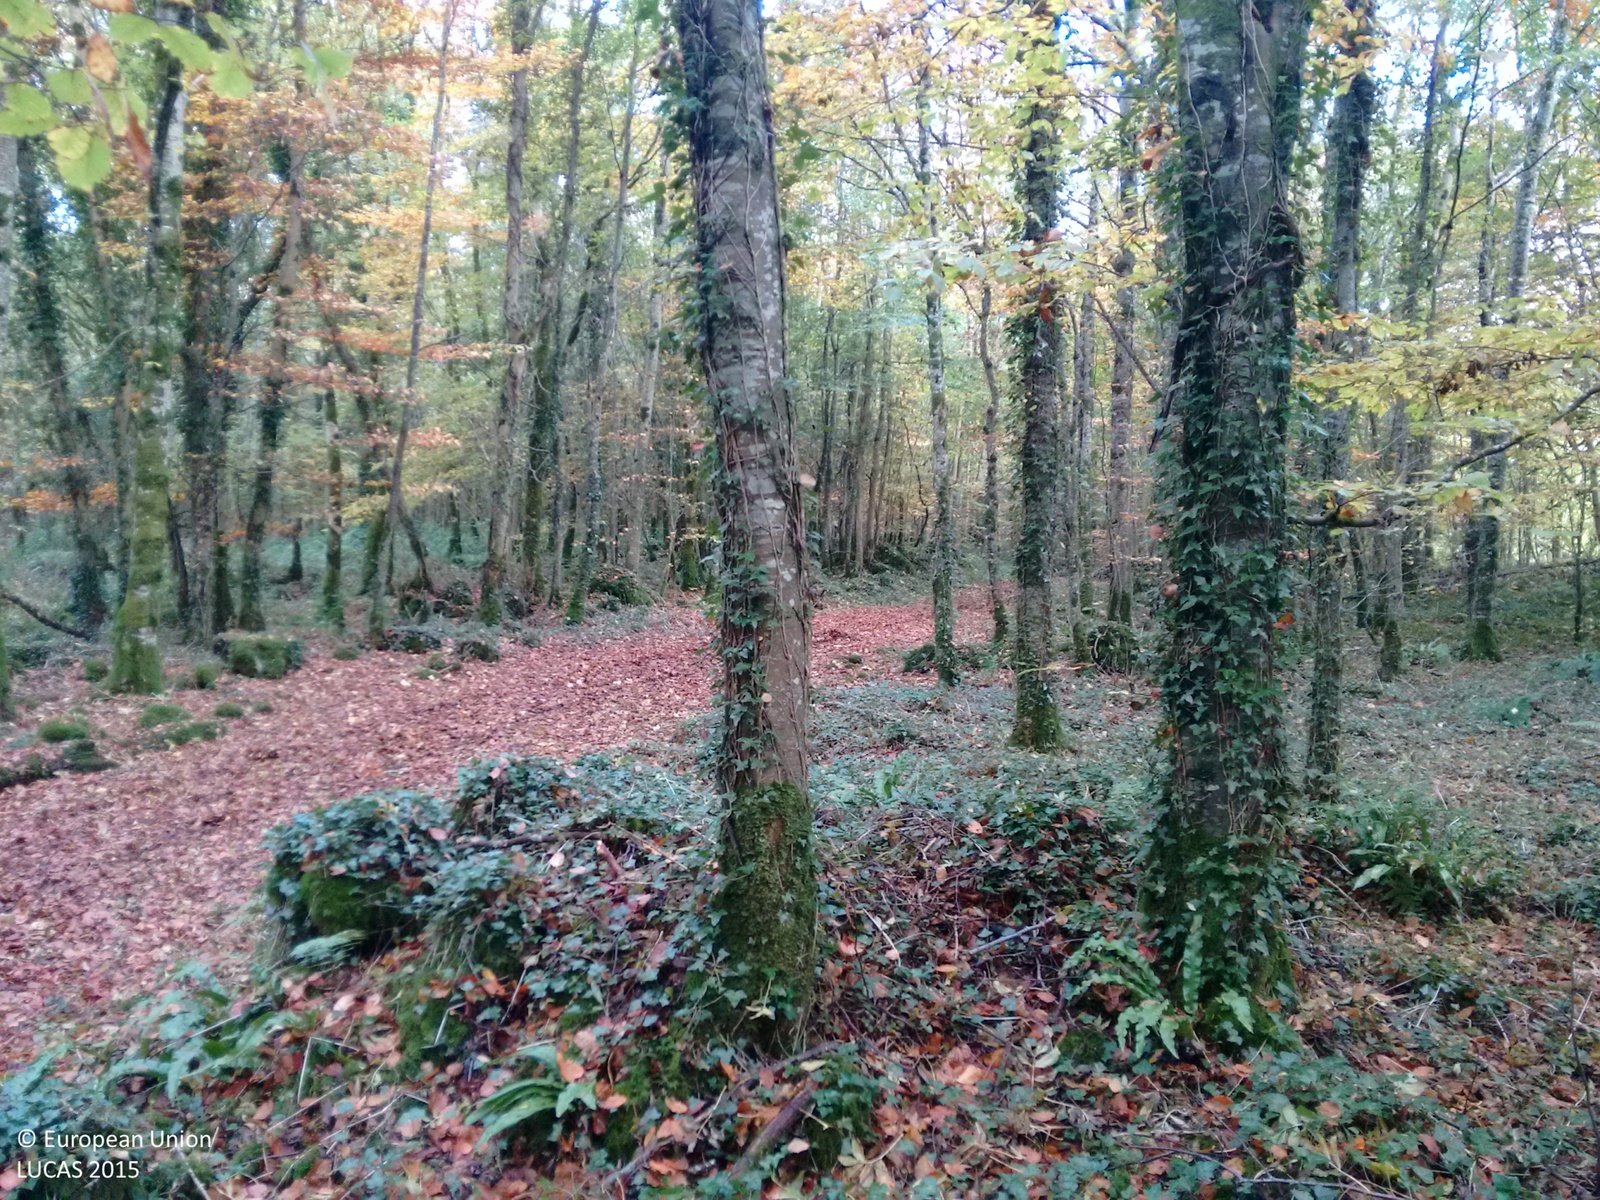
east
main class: Woodland
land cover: Broadleaved woodland
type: acidophilous oak and oak-birch forest
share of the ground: > 75 %
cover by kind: broadleaved forest trees 95 %, herbaceous plants 5 %
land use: Amenities, museums, leisure
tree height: > 5 m
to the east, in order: Broadleaved woodland; Tracks; Broadleaved woodland; Paved roads, cycling and walking lanes
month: October
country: IE
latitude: 53.9738
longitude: -8.2498
